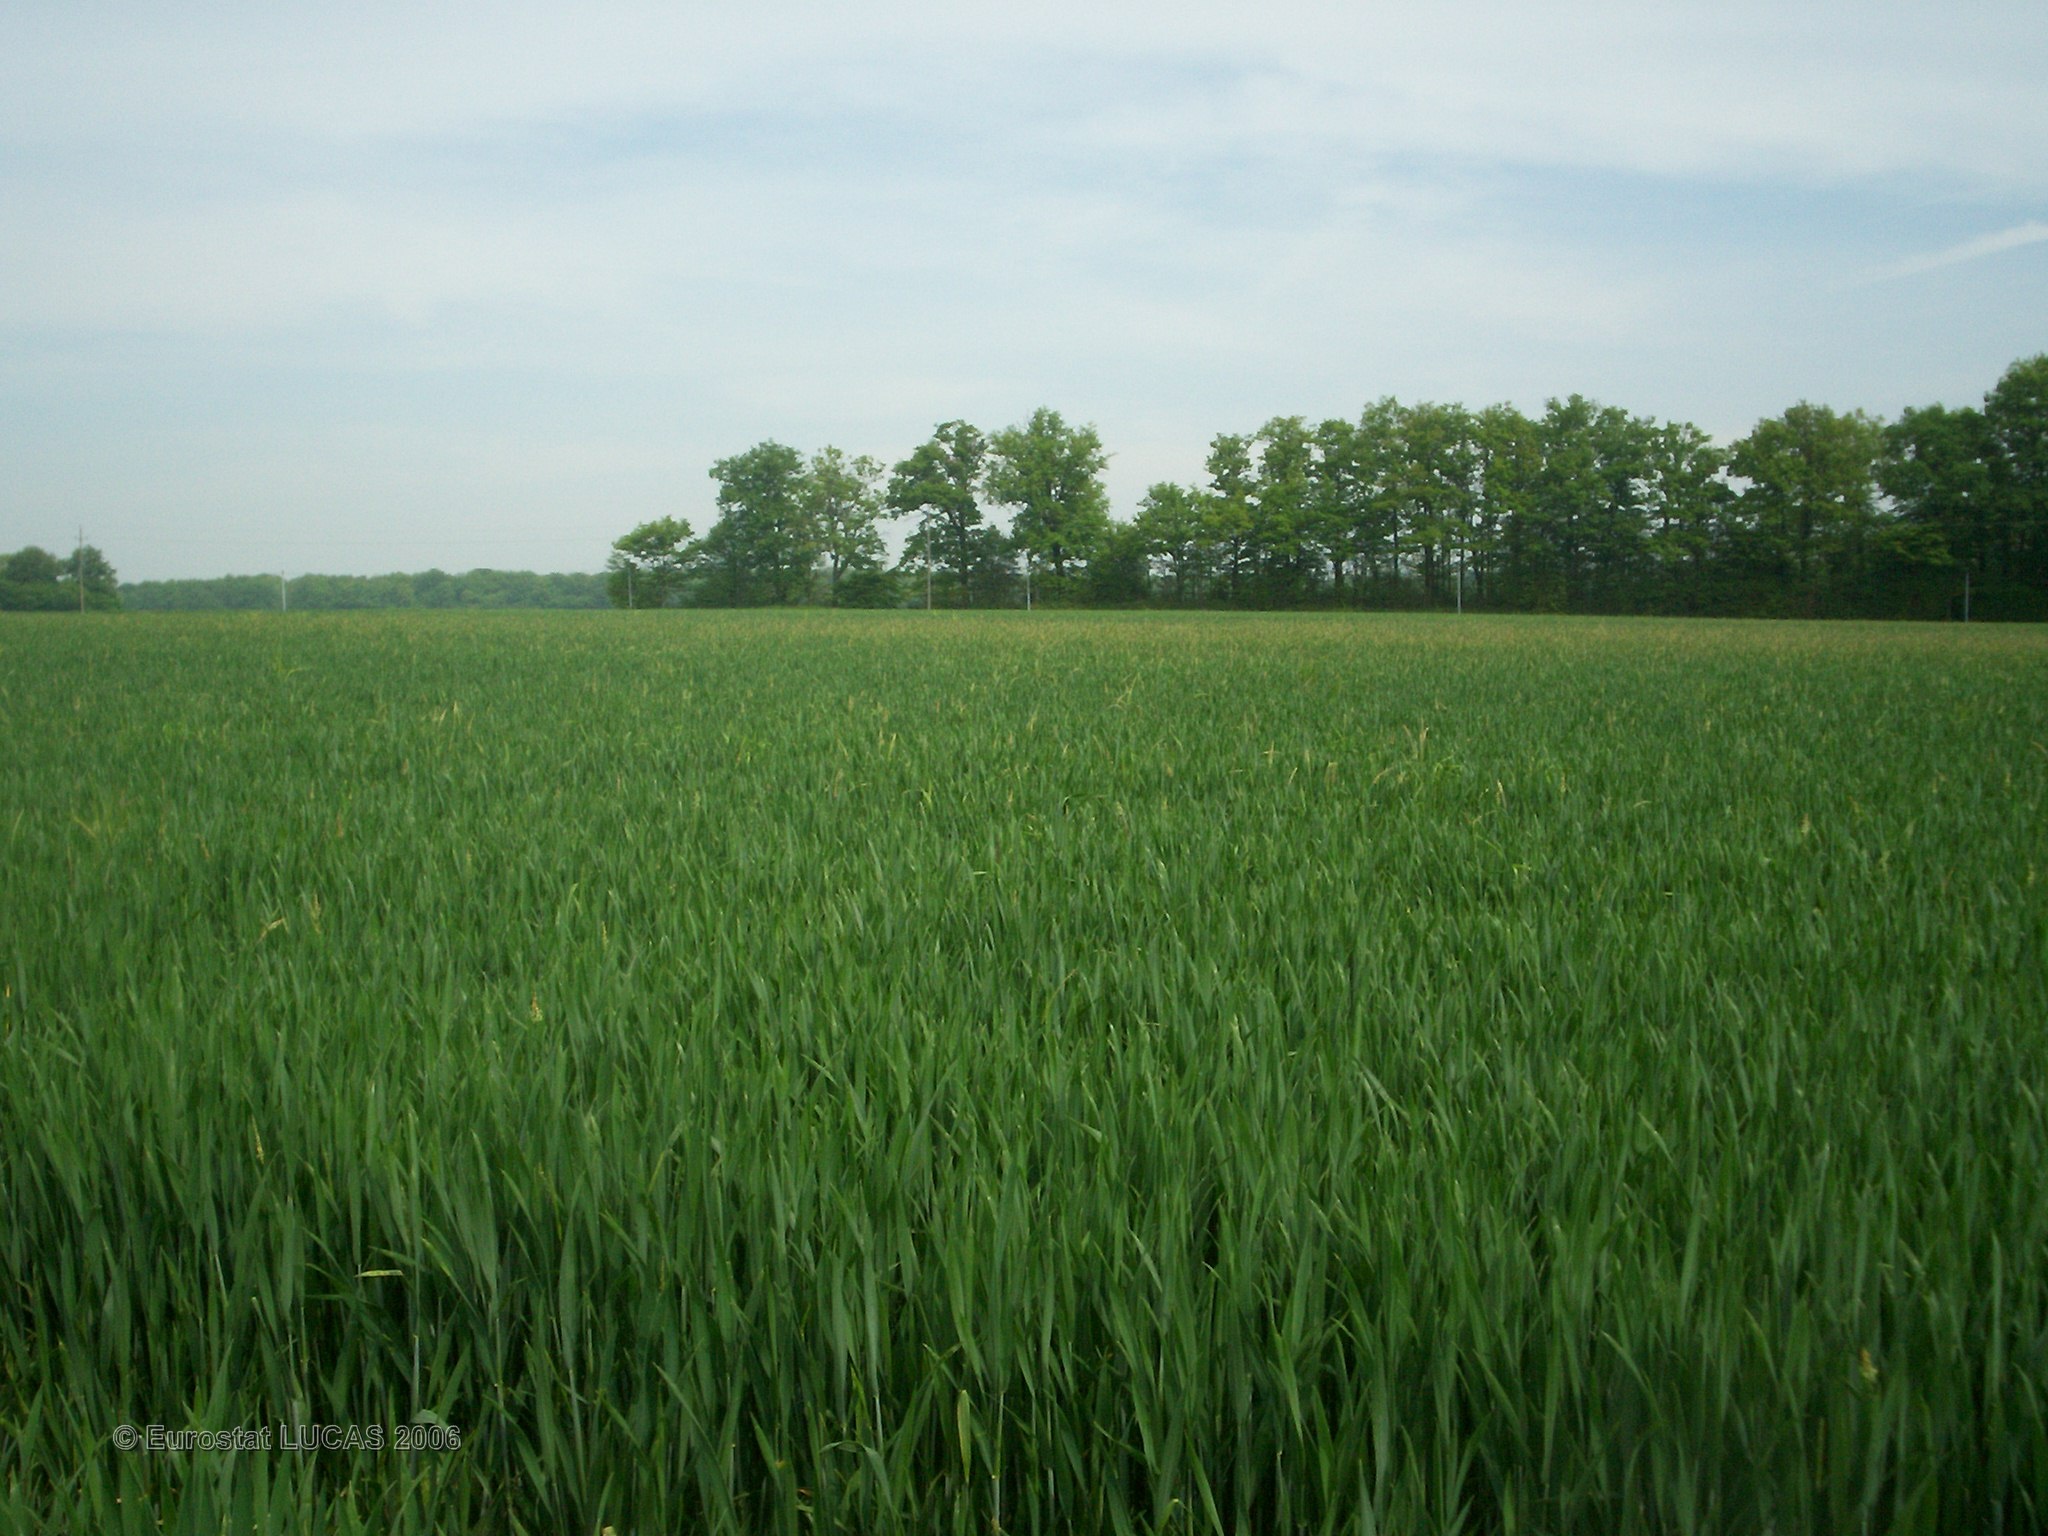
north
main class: Cropland
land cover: Common wheat
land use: Agriculture (excluding fallow land and kitchen gardens)
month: May
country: FR
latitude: 47.7637
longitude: 2.9622
